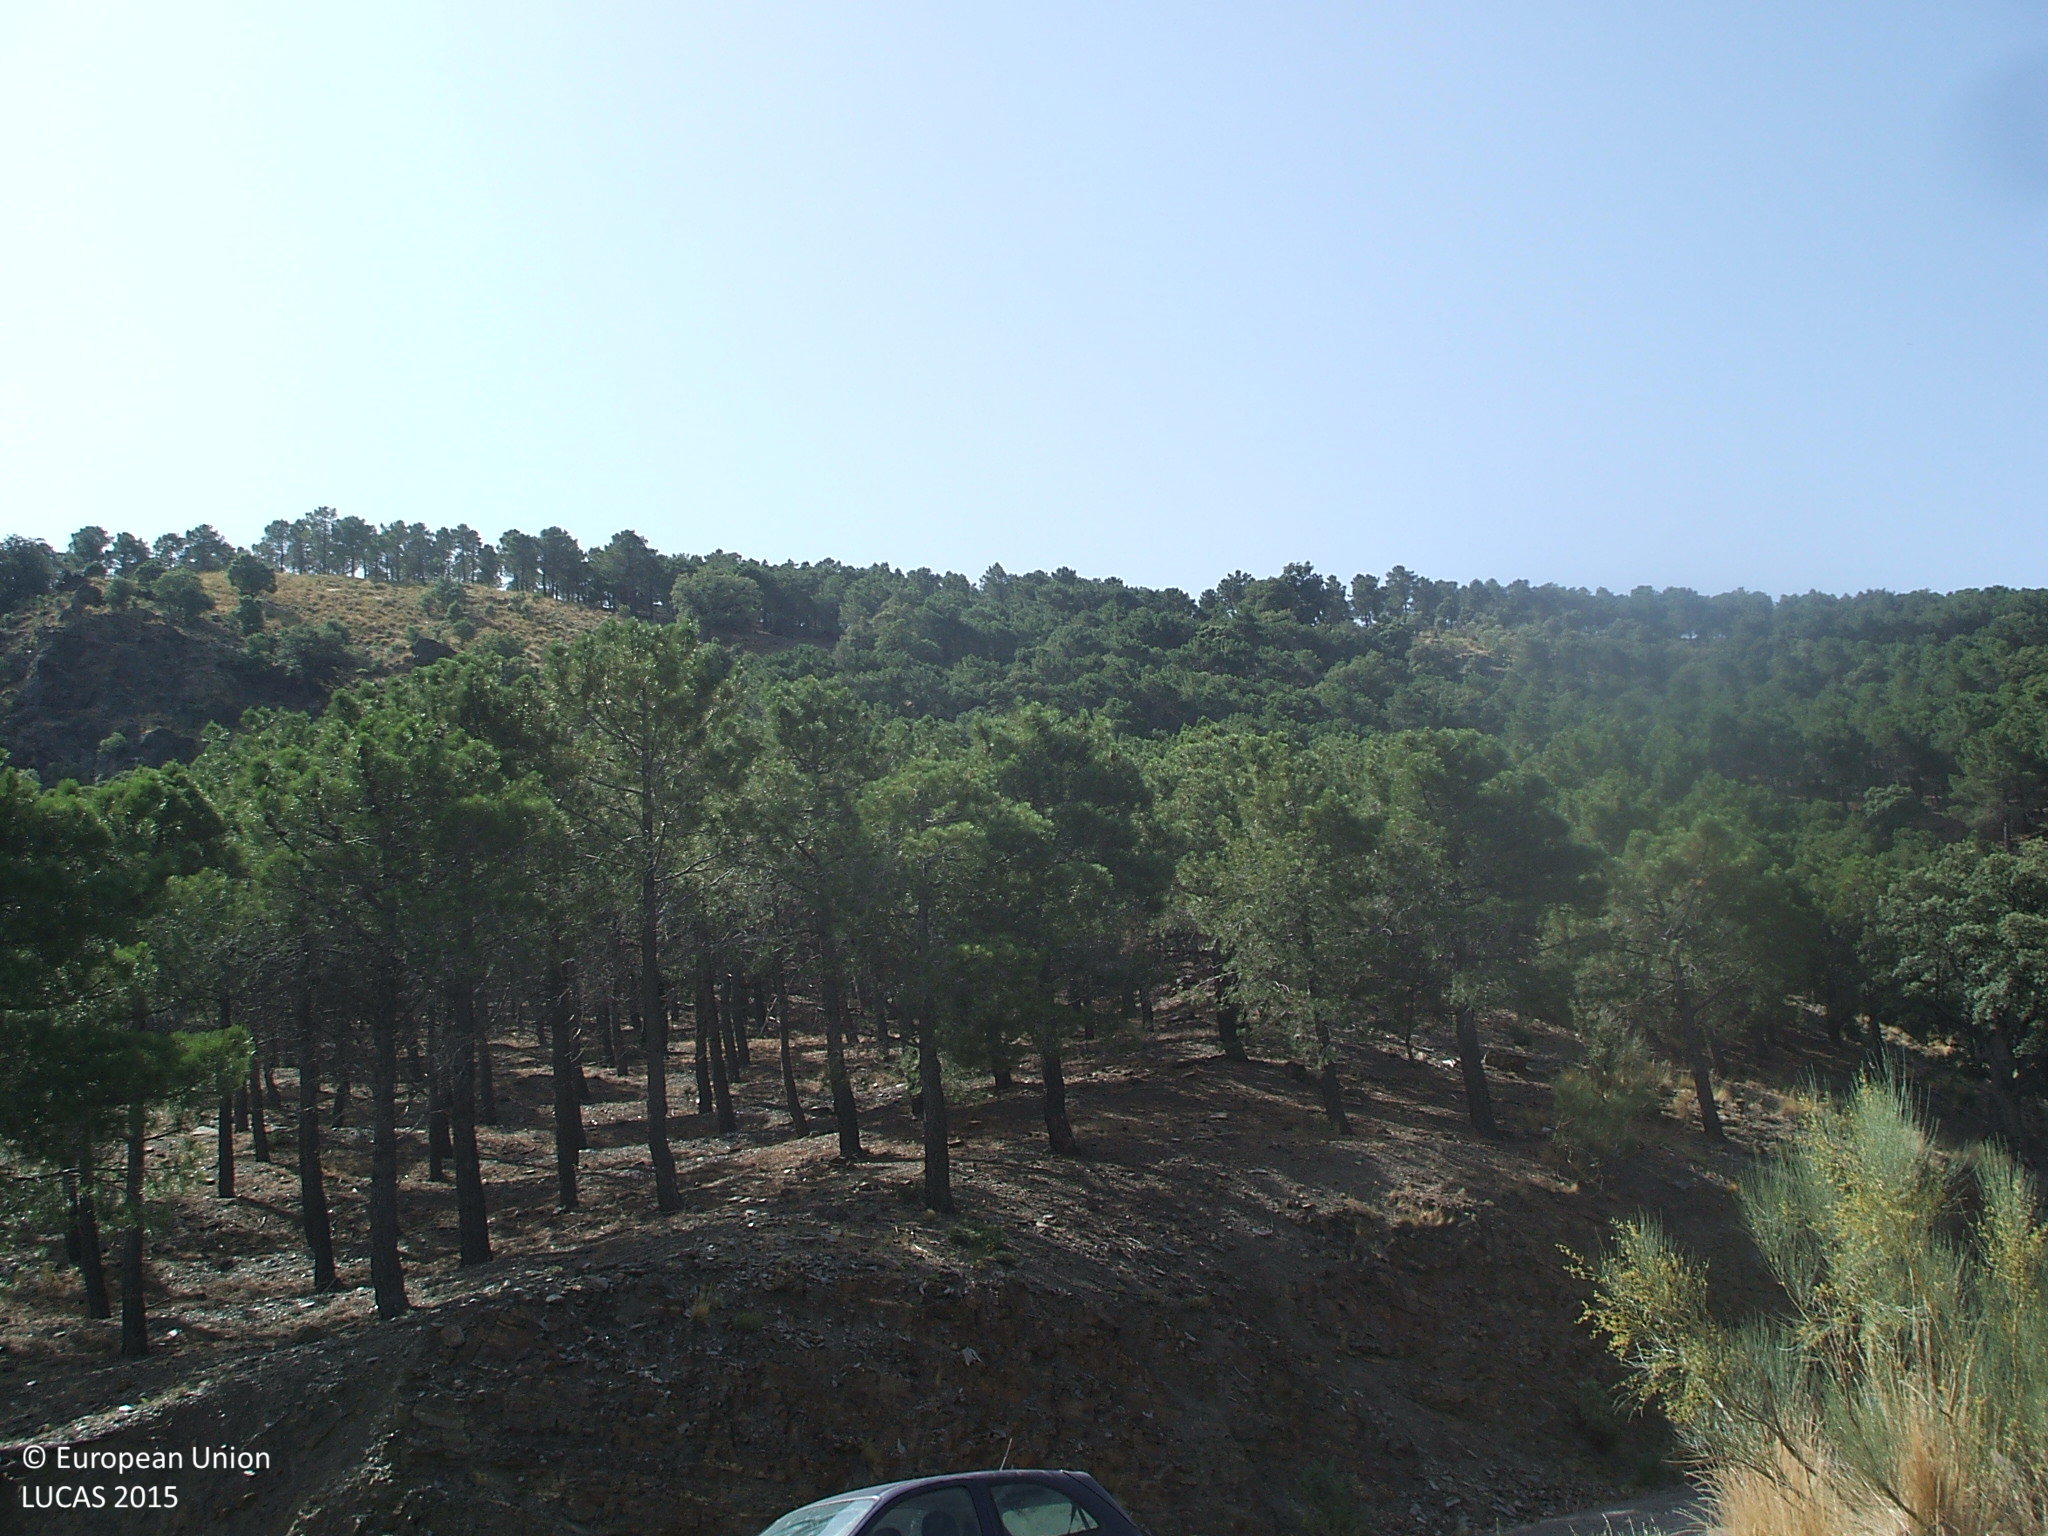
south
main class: Woodland
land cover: Other mixed woodland
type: coniferous forest of the mediterranean region
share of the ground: 25 - 50 %
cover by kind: coniferous forest trees 40 %, broadleaved forest trees 30 %, shrubs 30 %
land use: Semi-natural and natural areas not in use
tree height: > 5 m
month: June
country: ES
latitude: 37.1110
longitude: -2.8445
